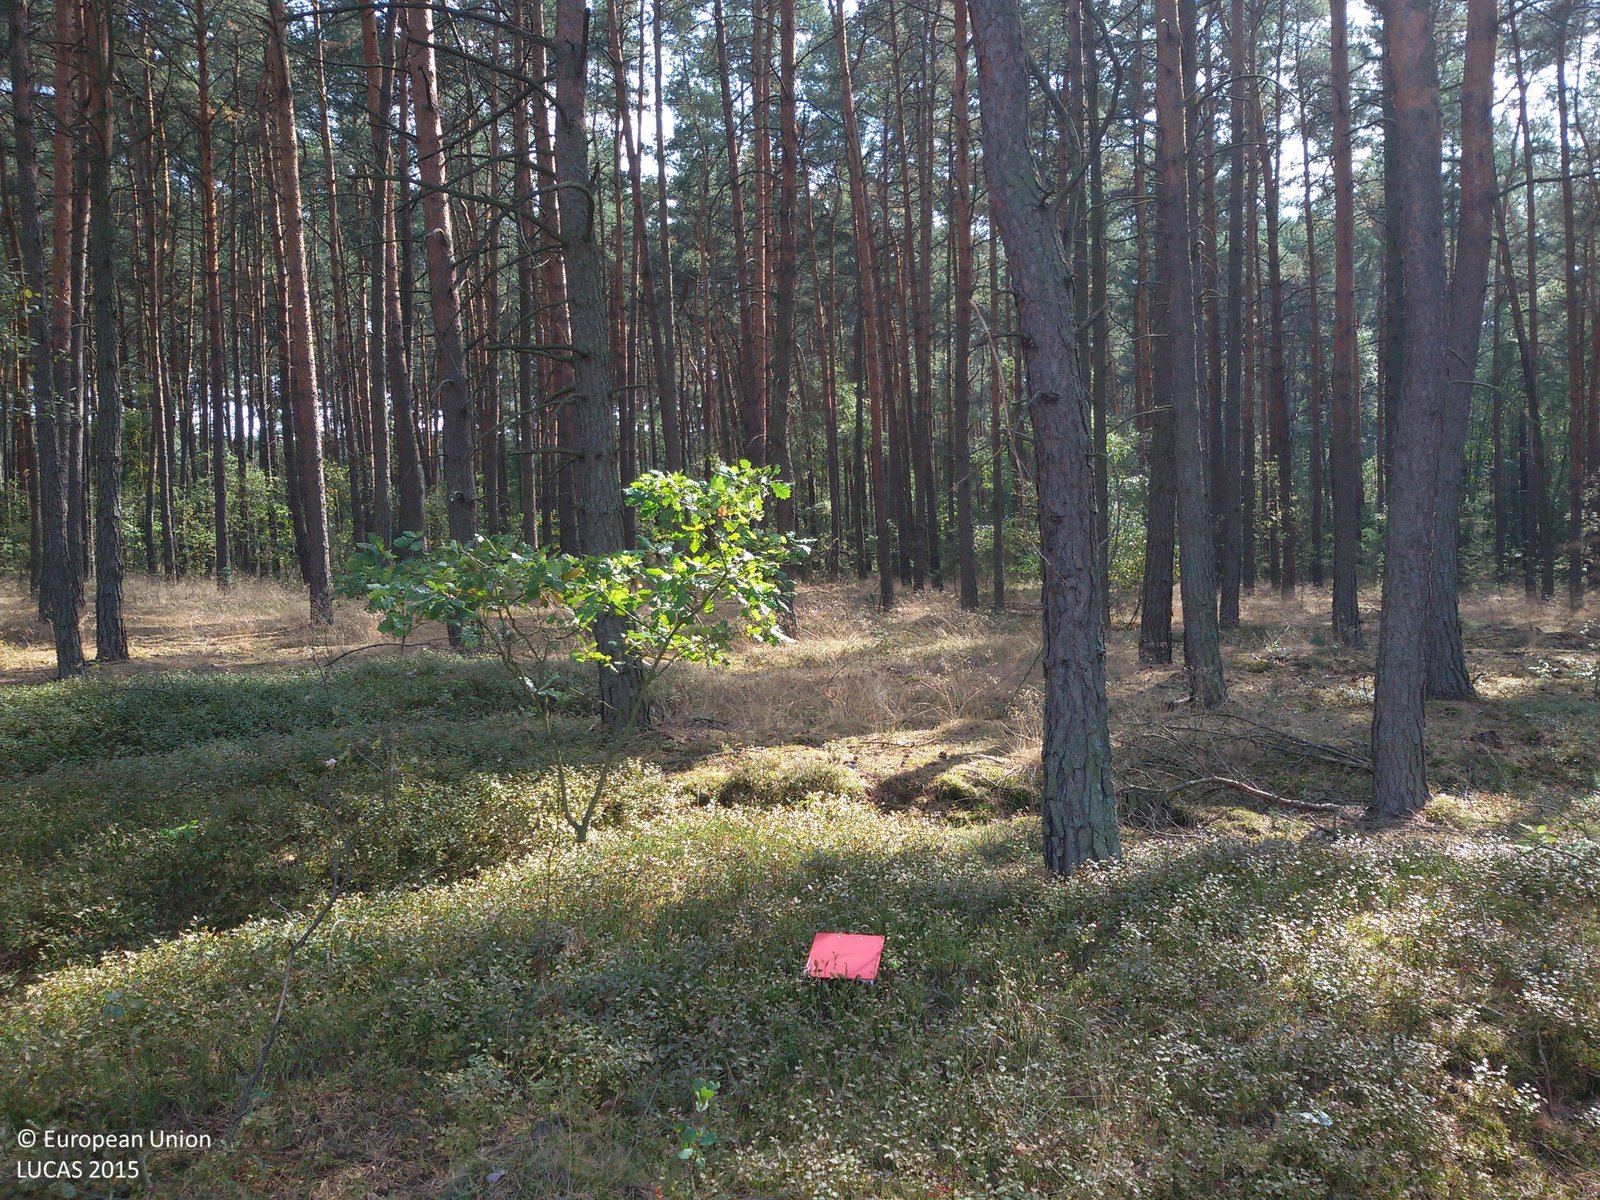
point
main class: Woodland
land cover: Pine dominated coniferous woodland
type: hemiboreal forest and nemoral coniferous forest and mixed broadleaved-coniferous forest
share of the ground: > 75 %
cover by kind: coniferous forest trees 70 %, broadleaved forest trees 10 %, shrubs 10 %, herbaceous plants 10 %
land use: Forestry
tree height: > 5 m
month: September
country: PL
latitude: 51.9682
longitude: 17.9189
